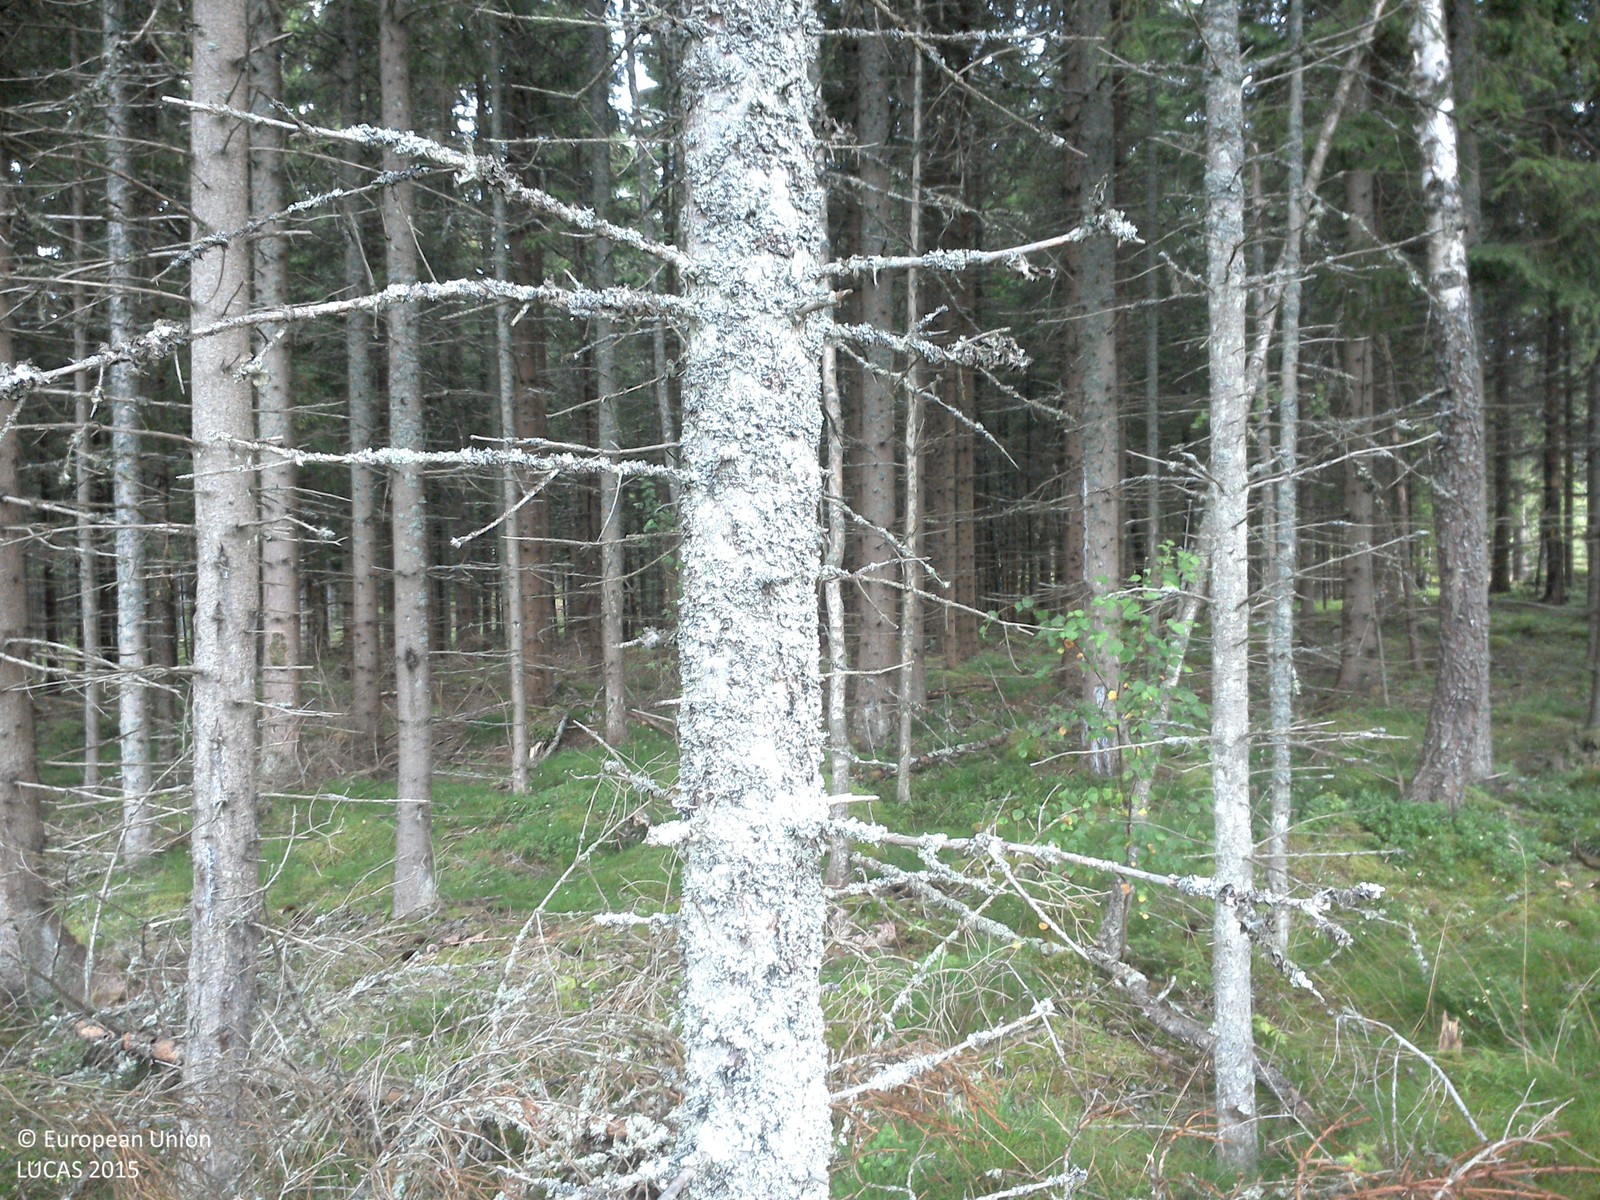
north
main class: Woodland
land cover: Spruce dominated coniferous woodland
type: boreal forest
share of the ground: > 75 %
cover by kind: coniferous forest trees 90 %, lichens and mosses 5 %, unconsolidated bare surface 5 %
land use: Forestry
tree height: > 5 m
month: August
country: SE
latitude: 57.7755
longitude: 15.2249
